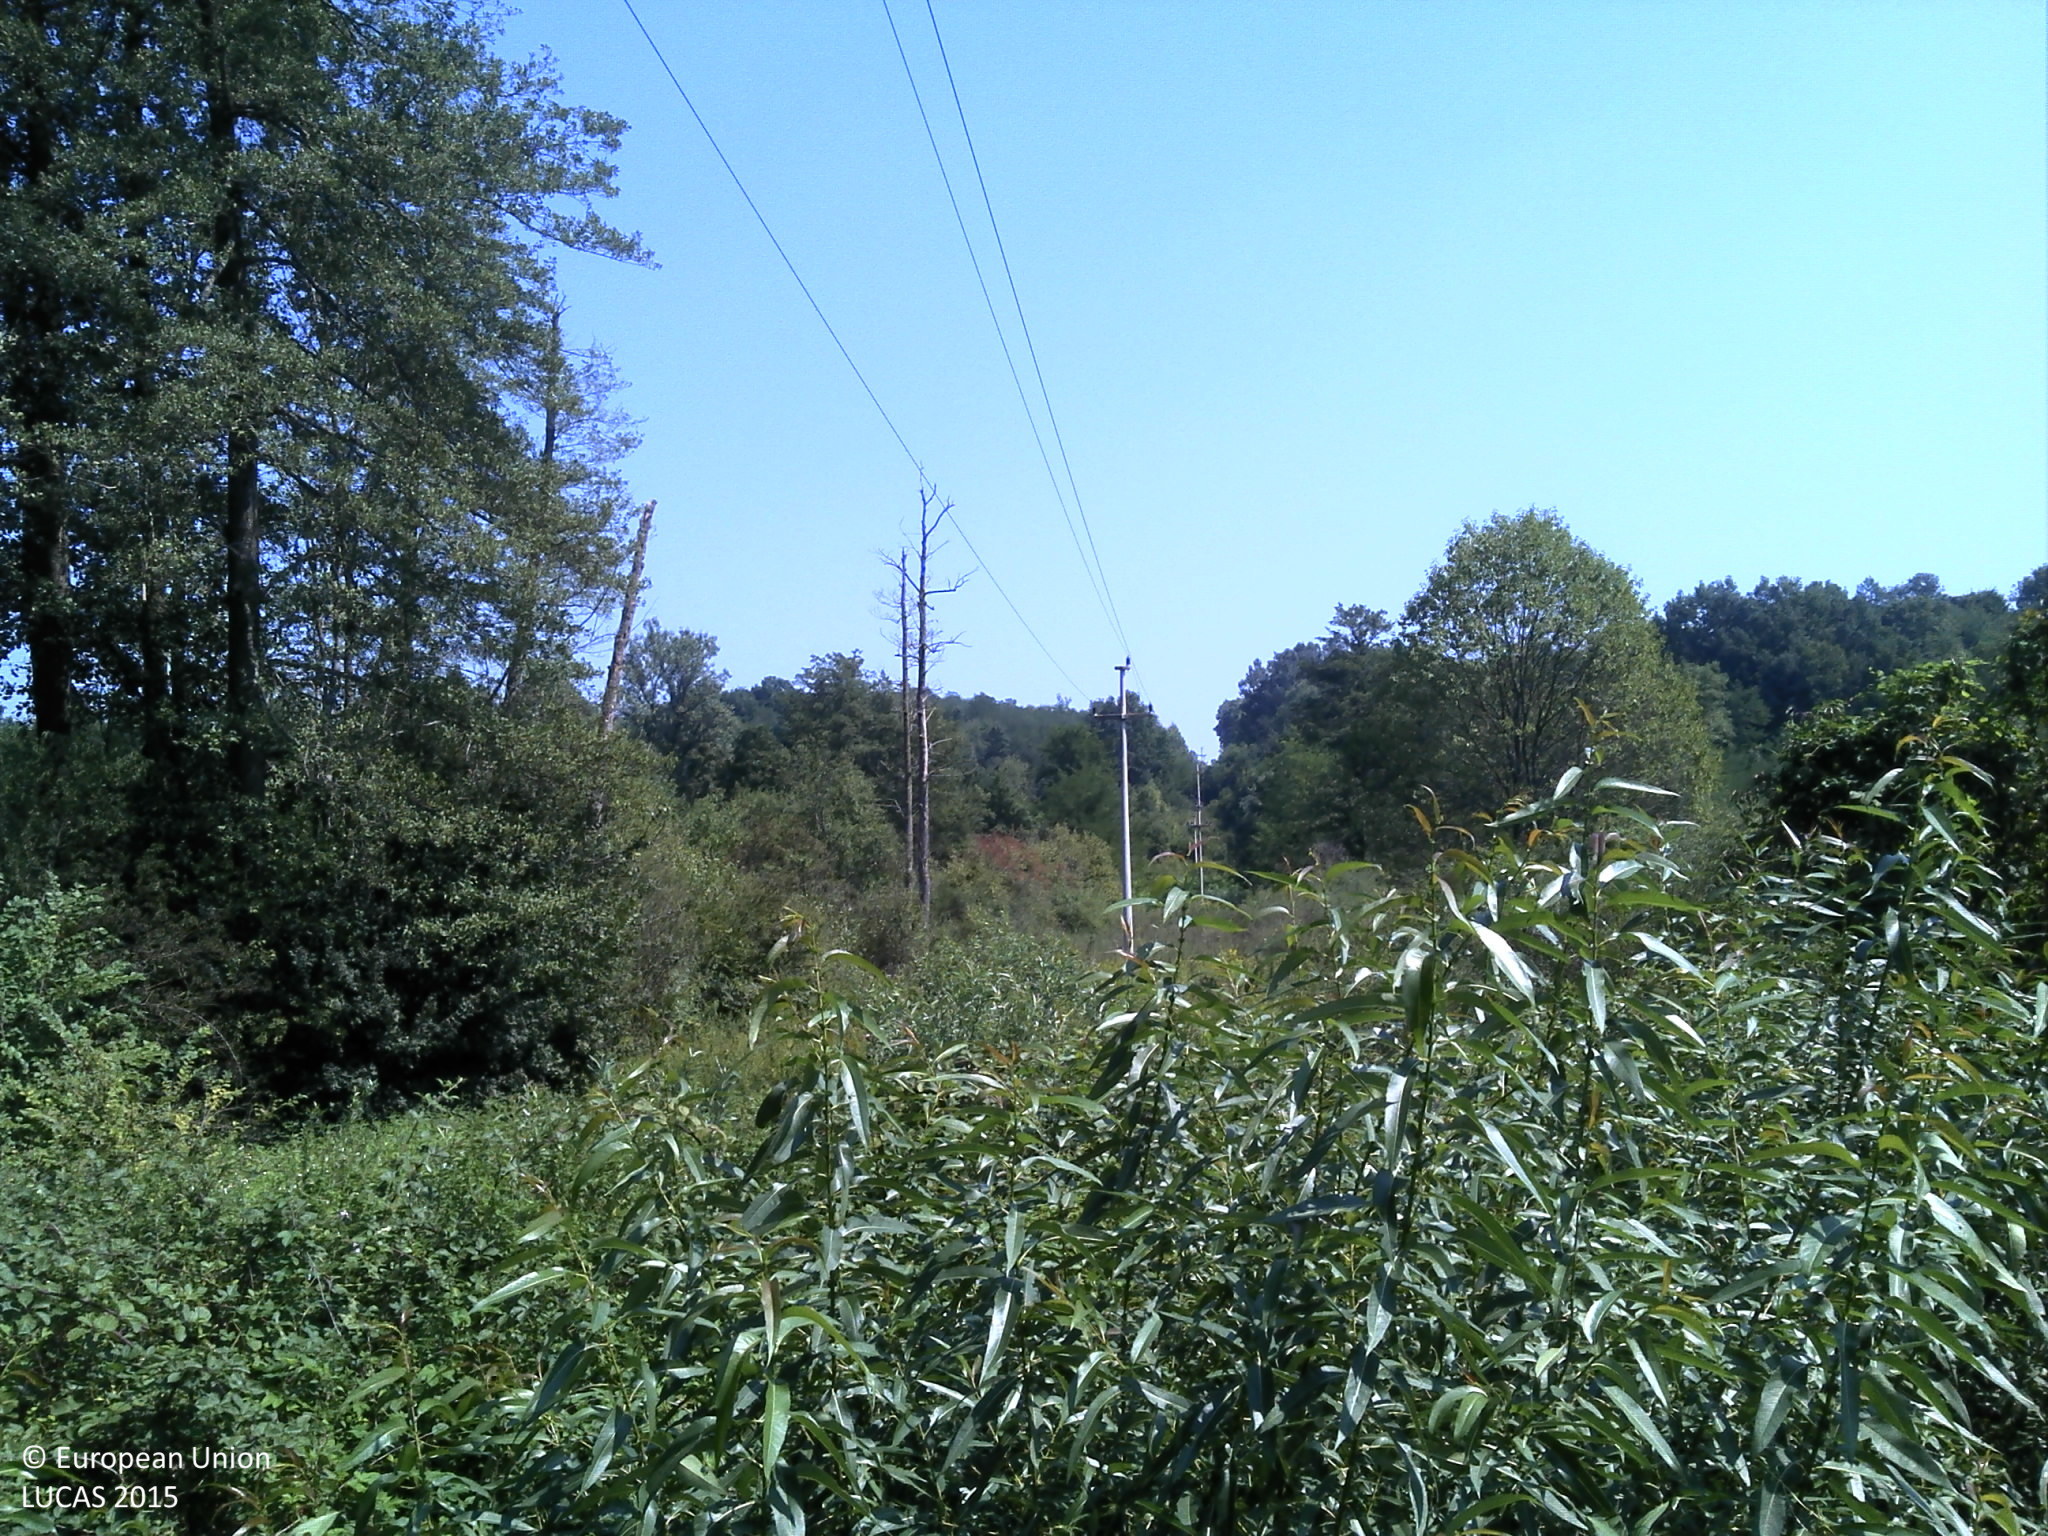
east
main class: Shrubland
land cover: Shrubland with sparse tree cover
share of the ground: > 75 %
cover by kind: shrubs 90 %, broadleaved forest trees 5 %, herbaceous plants 5 %
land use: Semi-natural and natural areas not in use
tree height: < 5 m
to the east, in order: Shrubland with sparse tree cover; Electric lines; Shrubland with sparse tree cover; Rivers and streams; Shrubland with sparse tree cover; Broadleaved woodland
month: August
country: HR
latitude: 45.3171
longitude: 16.2860
